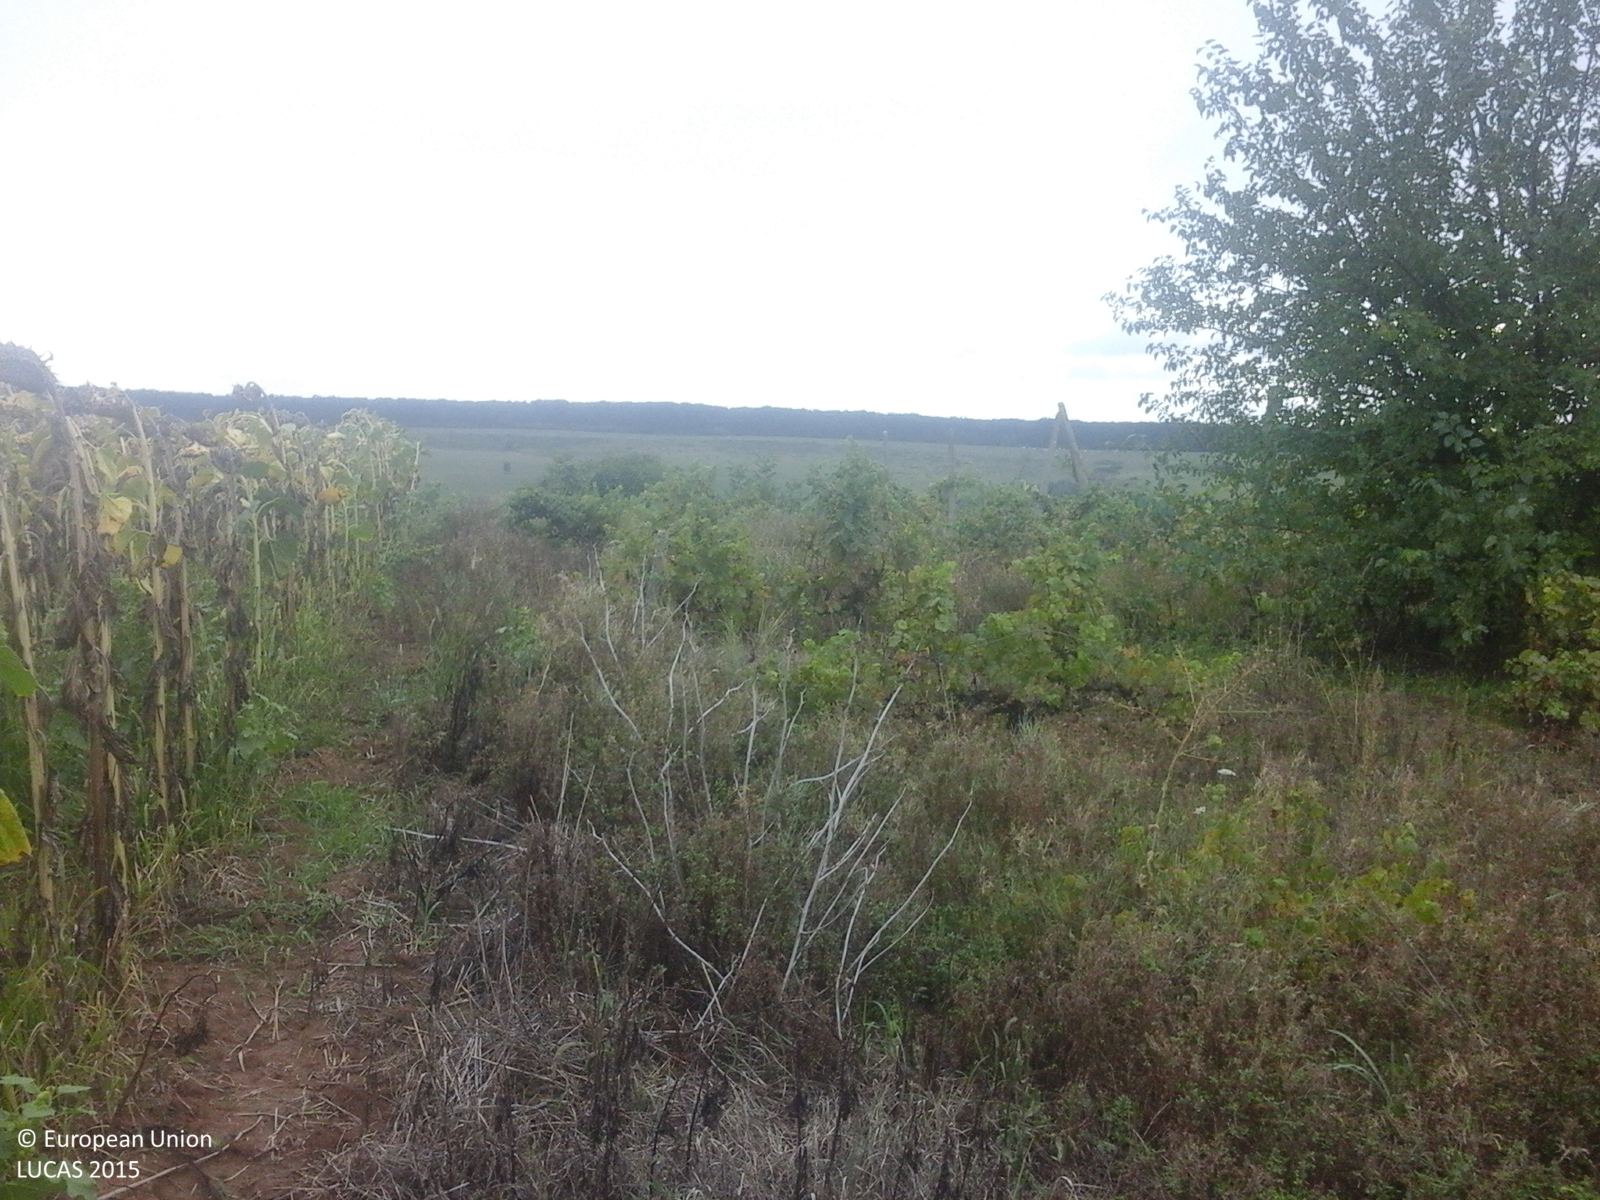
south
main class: Cropland
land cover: Sunflower
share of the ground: > 75 %
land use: Agriculture (excluding fallow land and kitchen gardens)
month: September
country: RO
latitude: 47.2938
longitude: 22.1503
